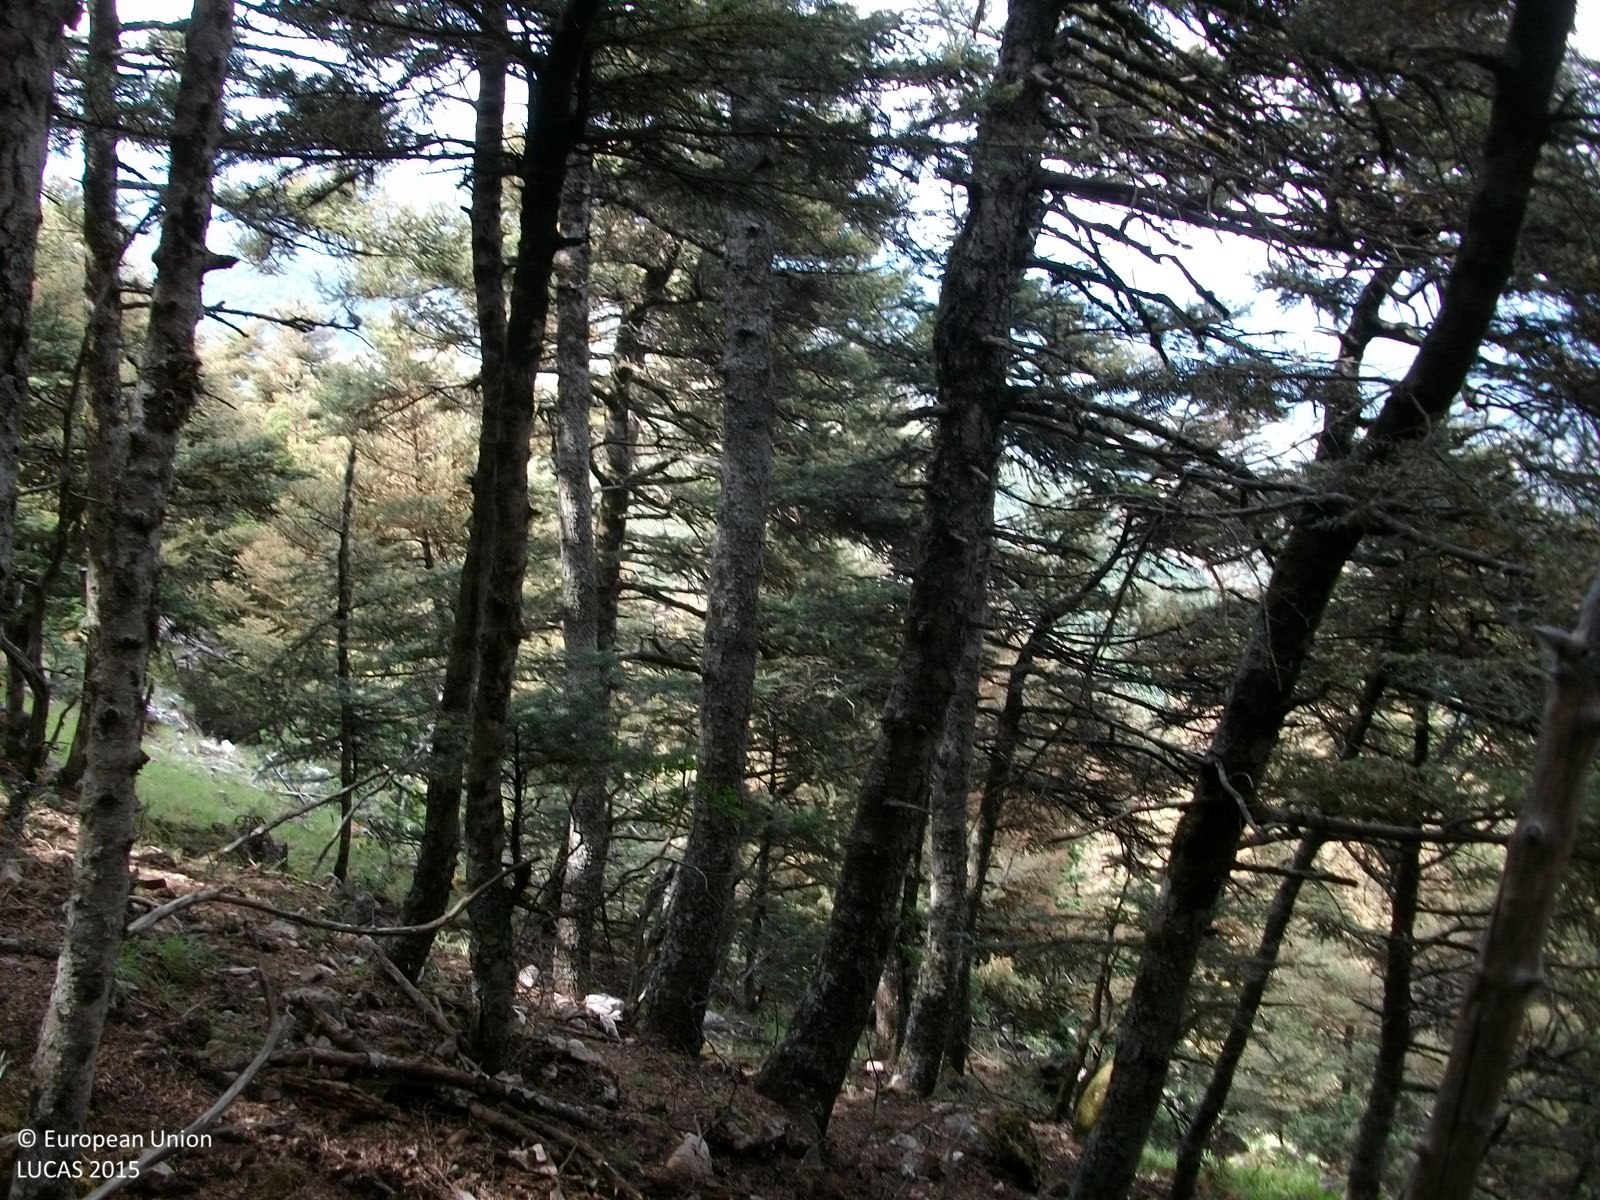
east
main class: Woodland
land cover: Spruce dominated coniferous woodland
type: coniferous forest of the mediterranean region
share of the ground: > 75 %
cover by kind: coniferous forest trees 100 %
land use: Forestry
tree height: > 5 m
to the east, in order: Spruce dominated coniferous woodland; Rock outcrops; Tracks; Grass margins; Spruce dominated coniferous woodland
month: June
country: GR
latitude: 36.8424
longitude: 22.3885
